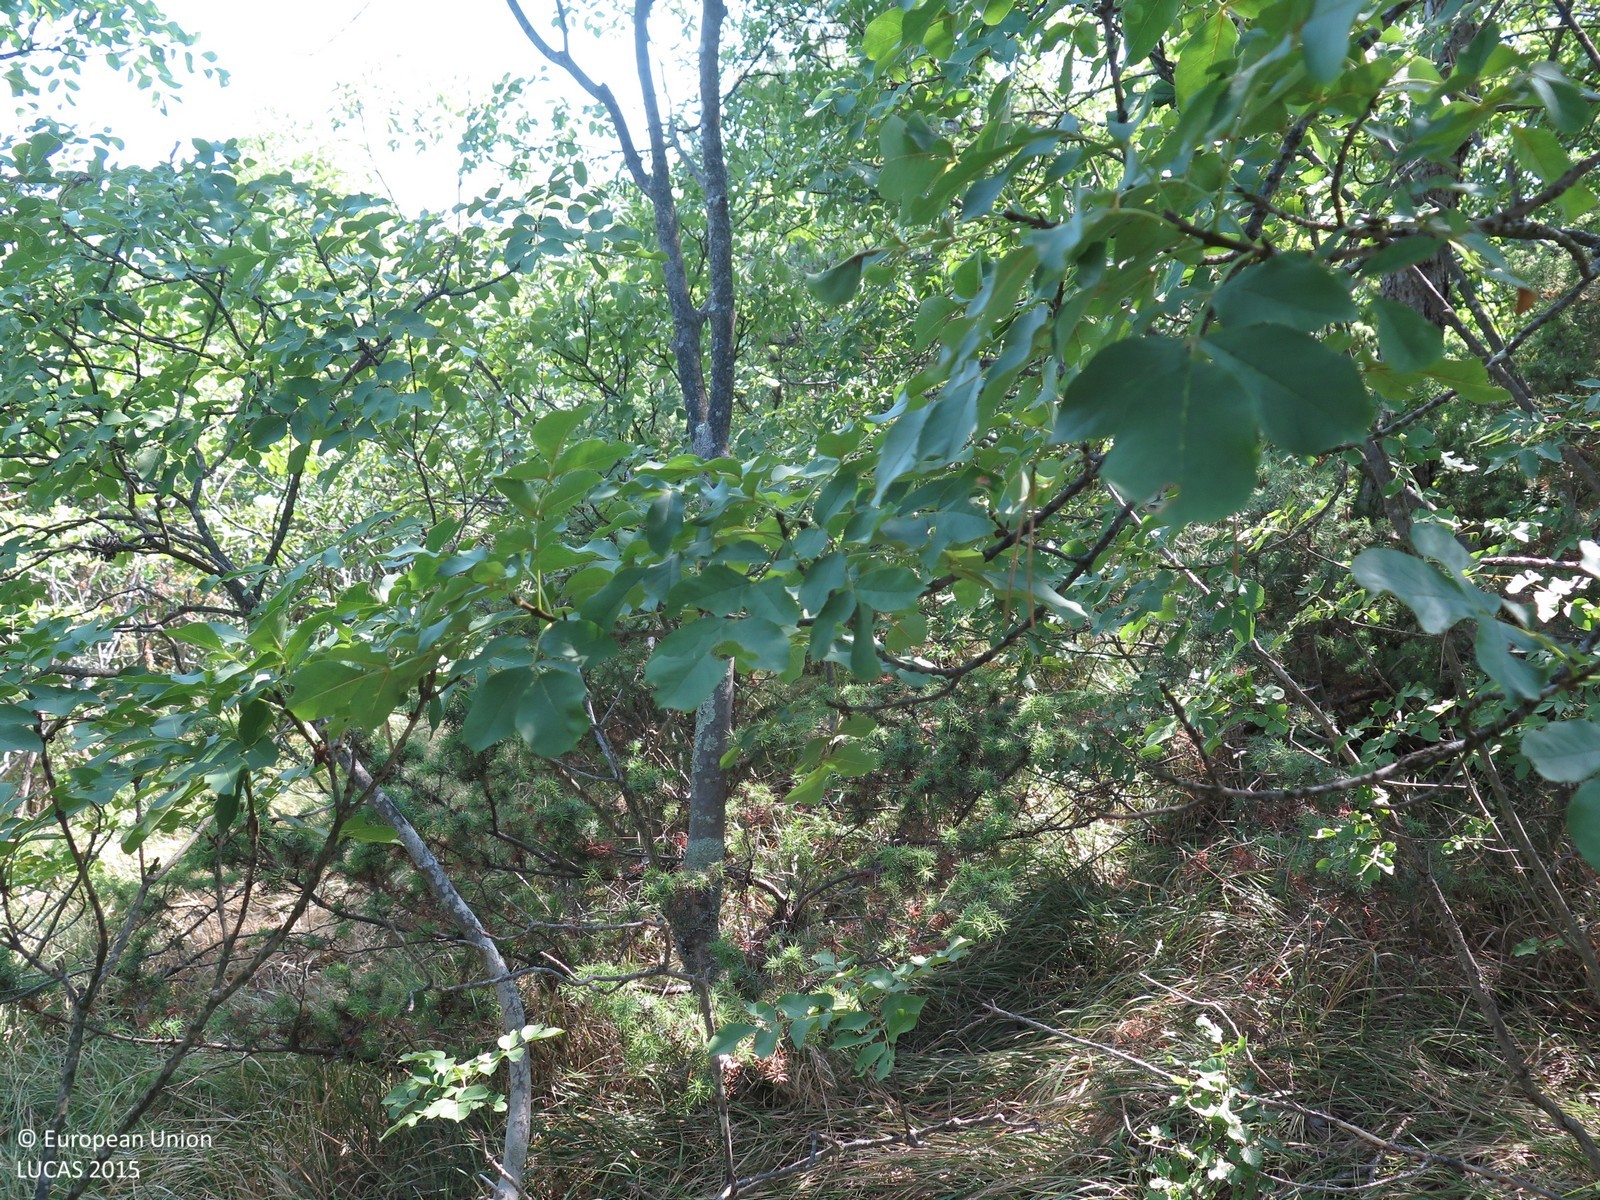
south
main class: Shrubland
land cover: Shrubland with sparse tree cover
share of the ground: > 75 %
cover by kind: shrubs 90 %, broadleaved forest trees 5 %, herbaceous plants 5 %
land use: Semi-natural and natural areas not in use
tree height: < 5 m
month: August
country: HR
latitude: 45.2210
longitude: 14.2354
